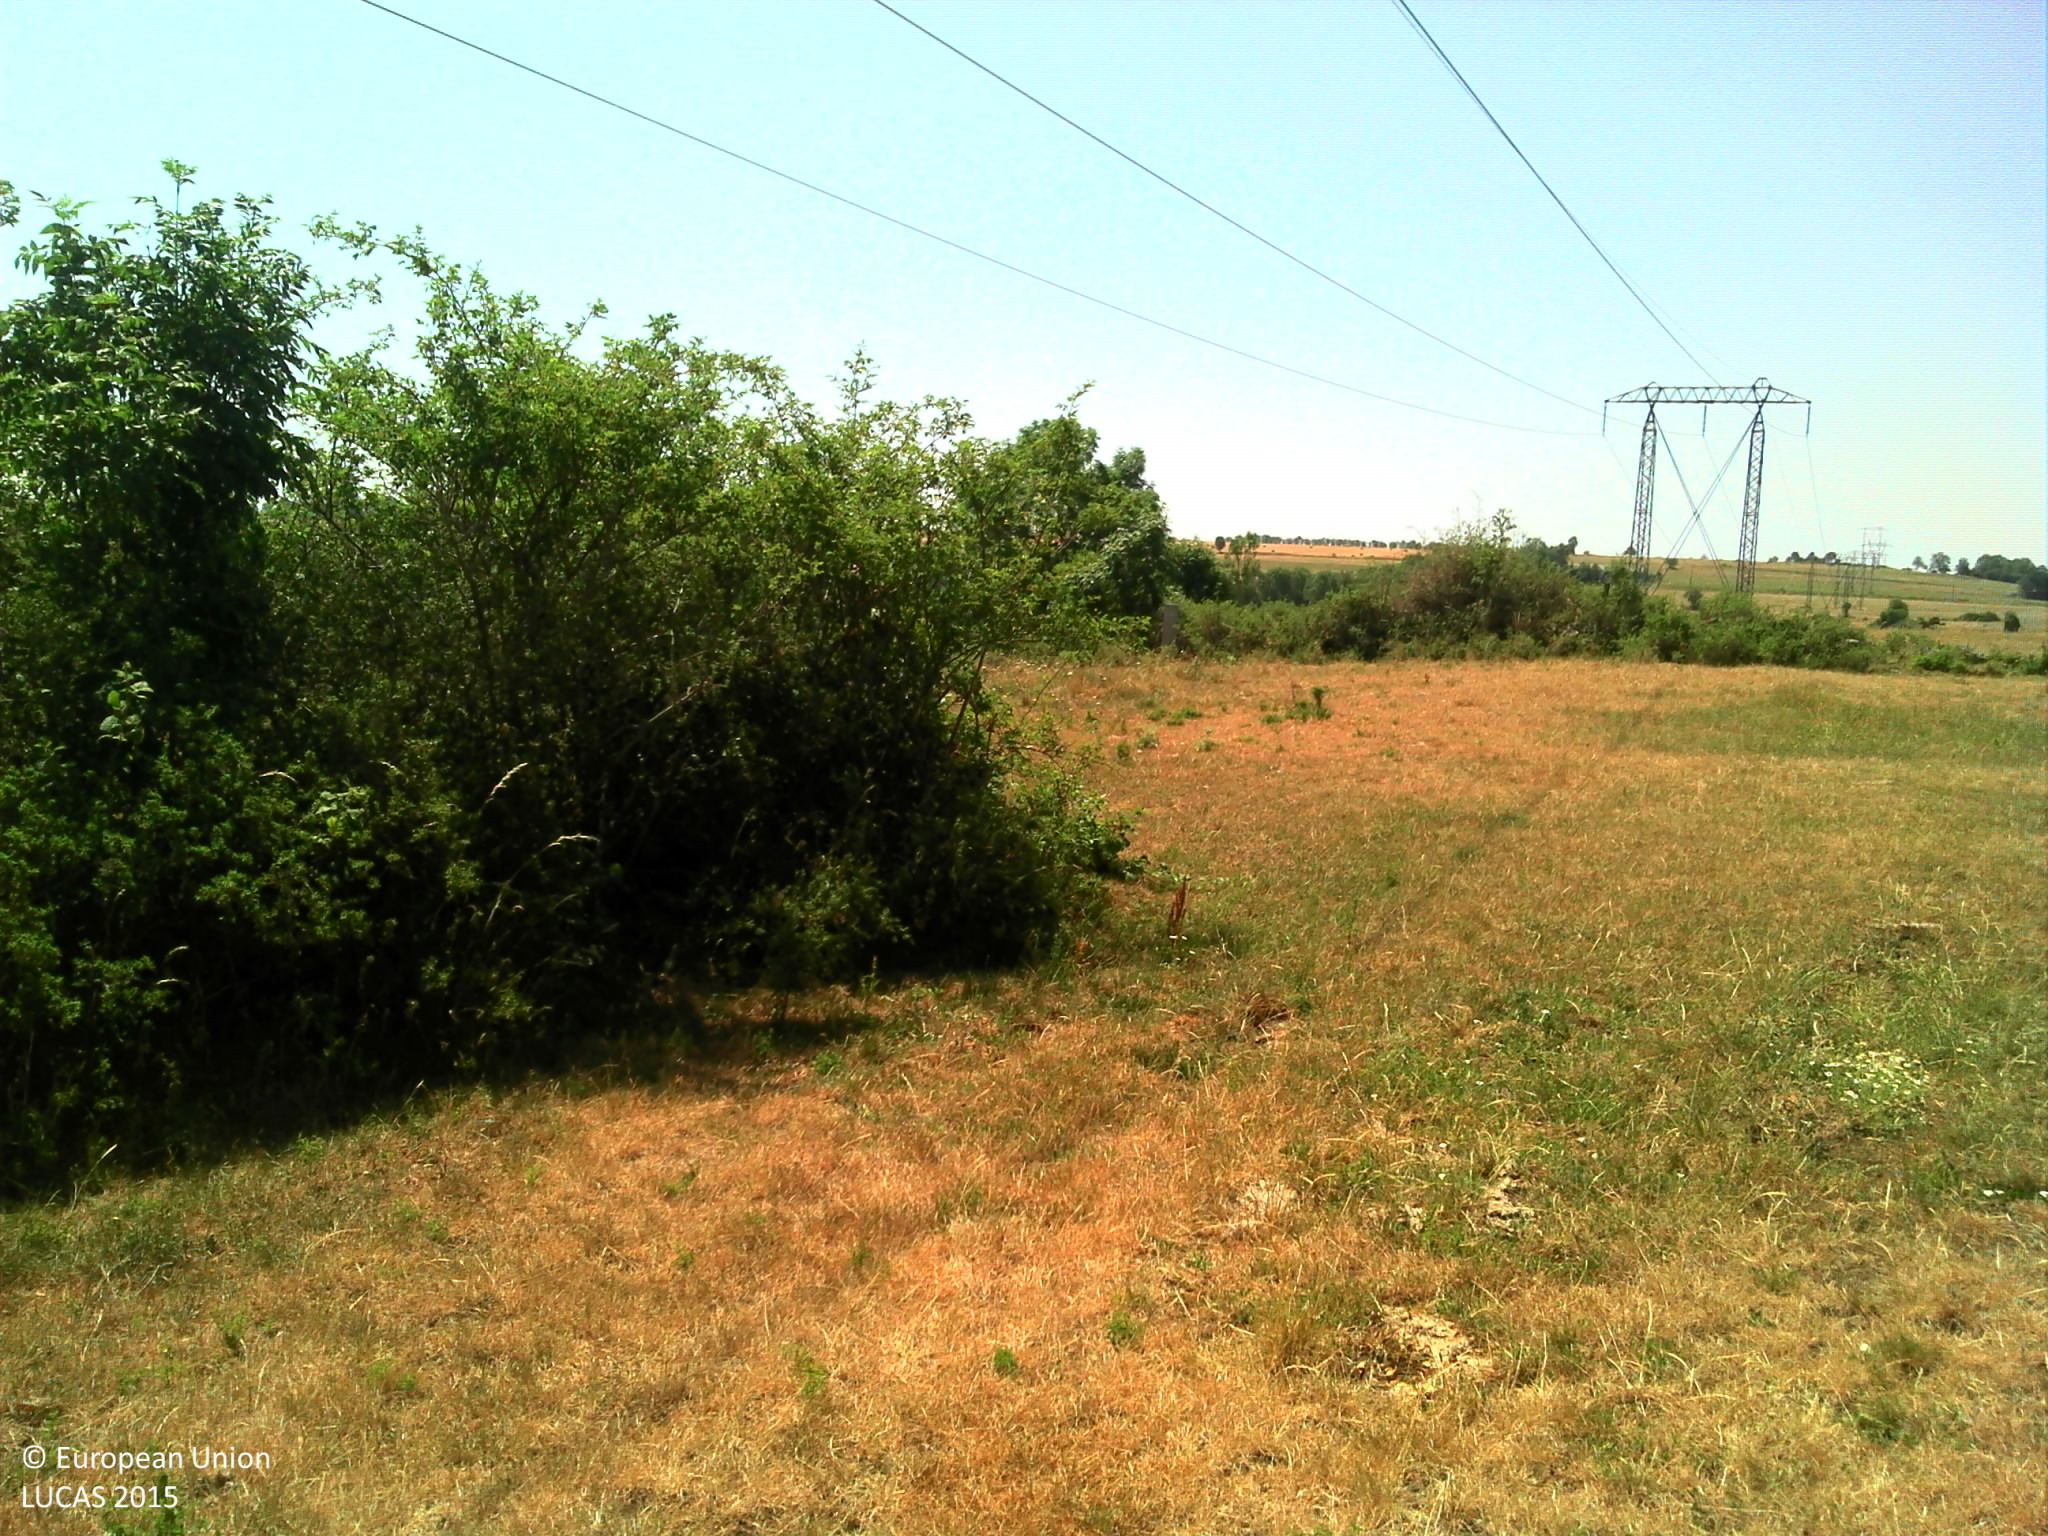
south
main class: Grassland
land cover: Grassland without tree/shrub cover
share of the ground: > 75 %
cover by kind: herbaceous plants 100 %
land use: Agriculture (excluding fallow land and kitchen gardens)
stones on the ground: < 10 %
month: July
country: FR
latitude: 45.0928
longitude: 3.0261
